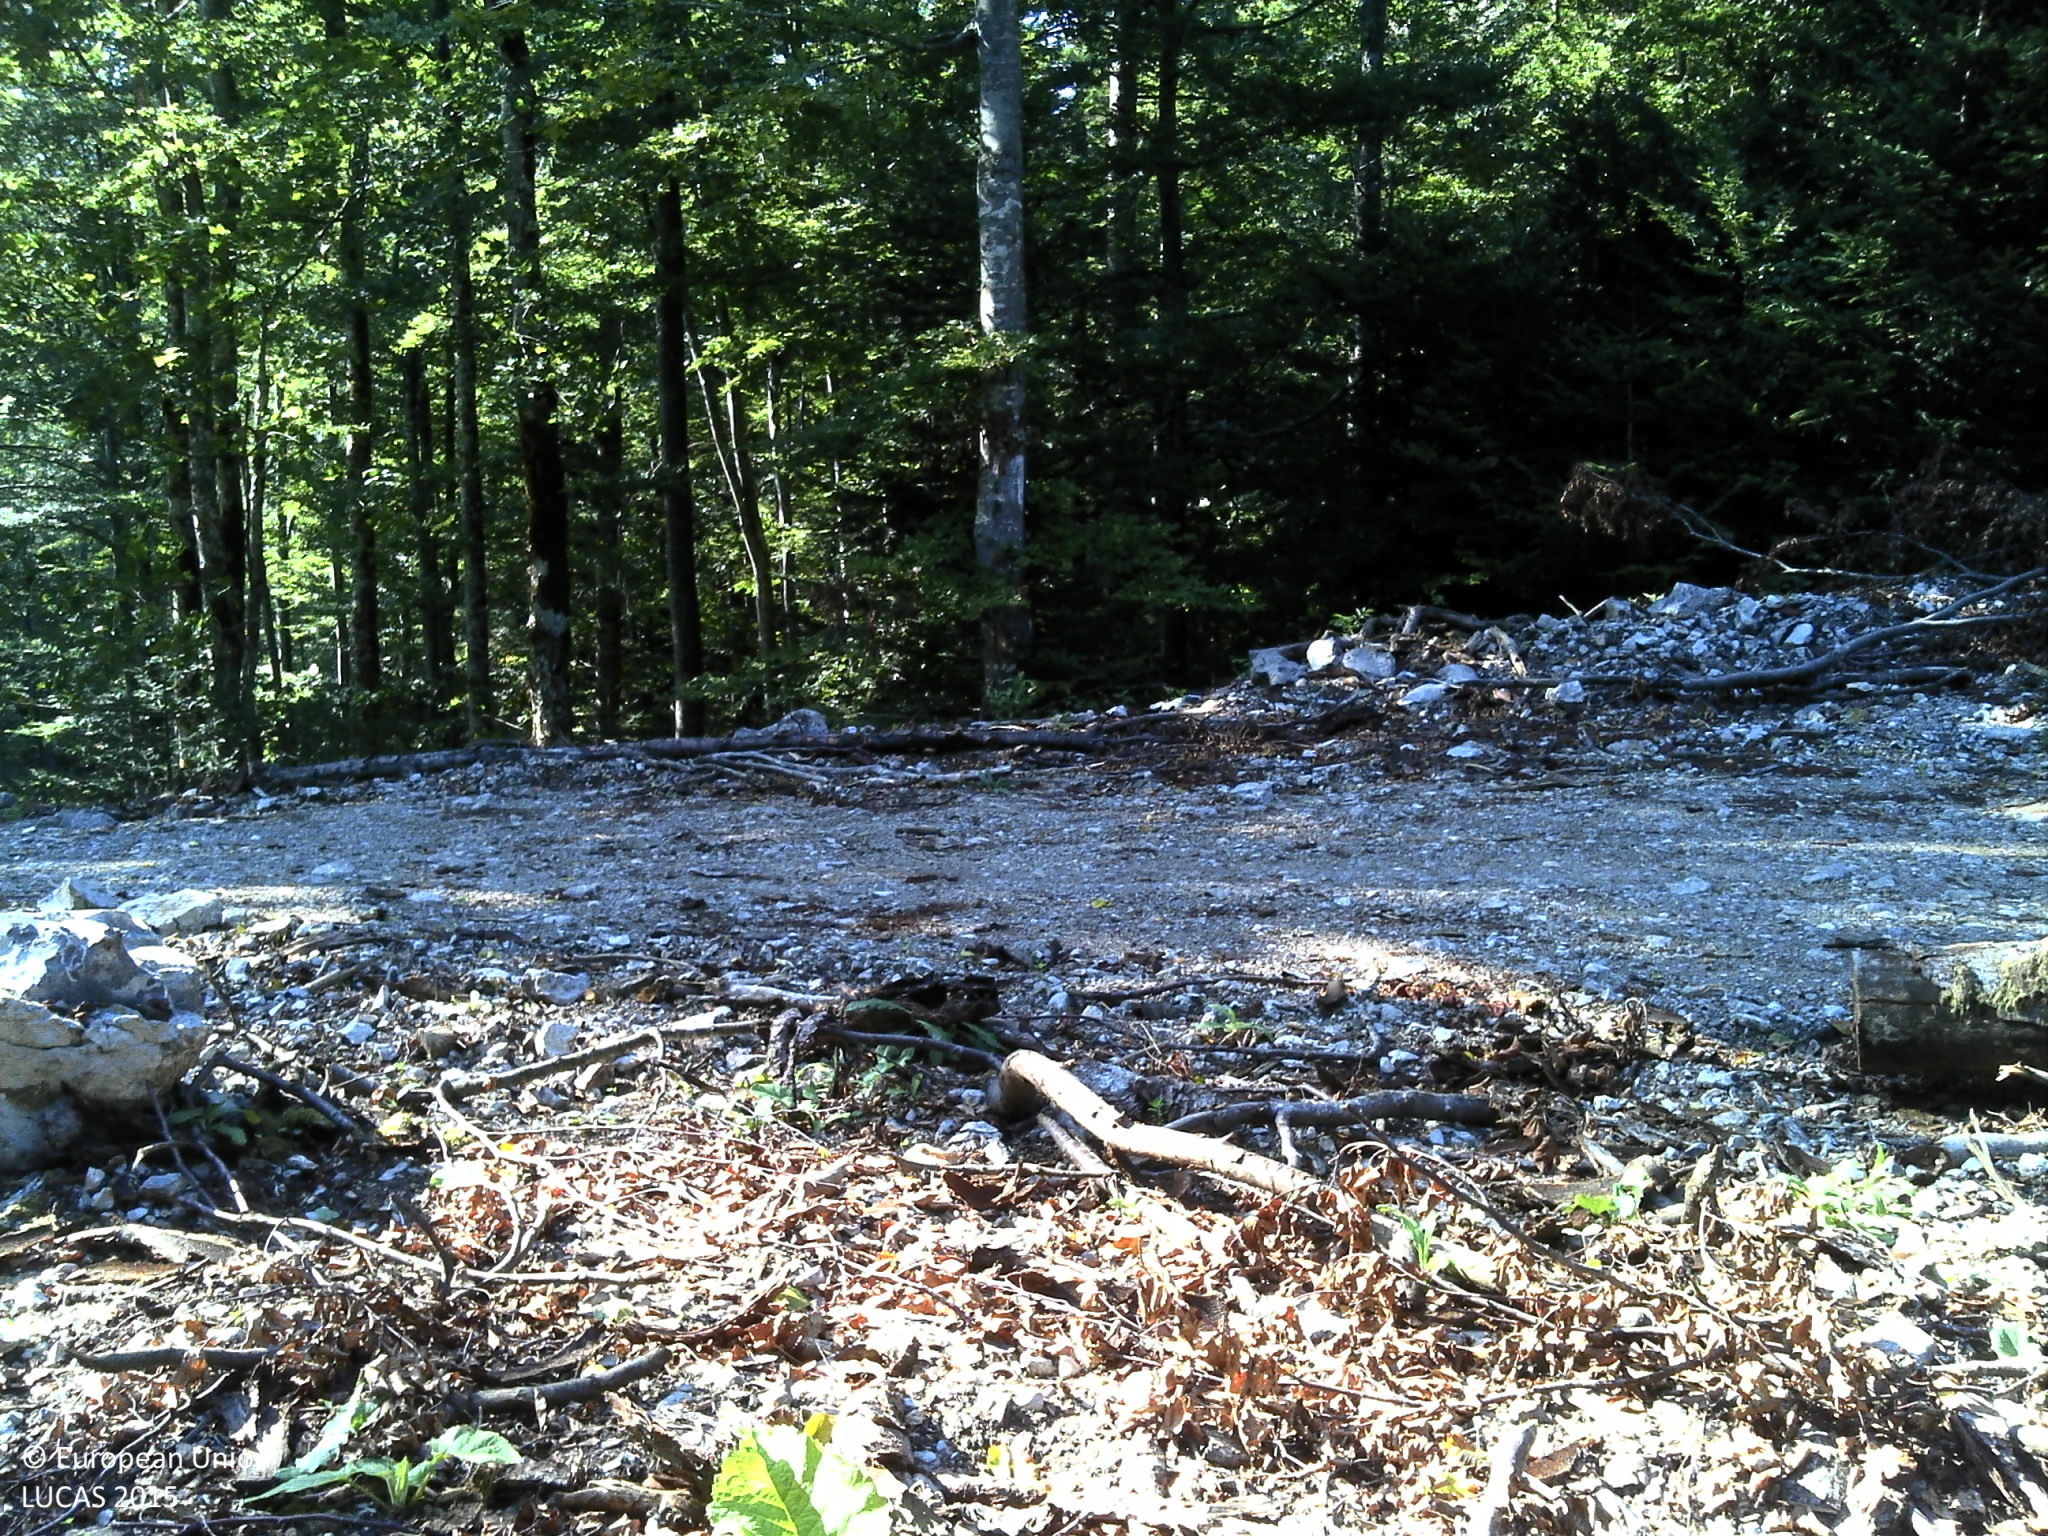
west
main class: Woodland
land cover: Broadleaved woodland
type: beech forest
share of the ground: > 75 %
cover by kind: broadleaved forest trees 100 %
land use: Forestry
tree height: > 5 m
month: September
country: HR
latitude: 45.2930
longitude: 15.0573
